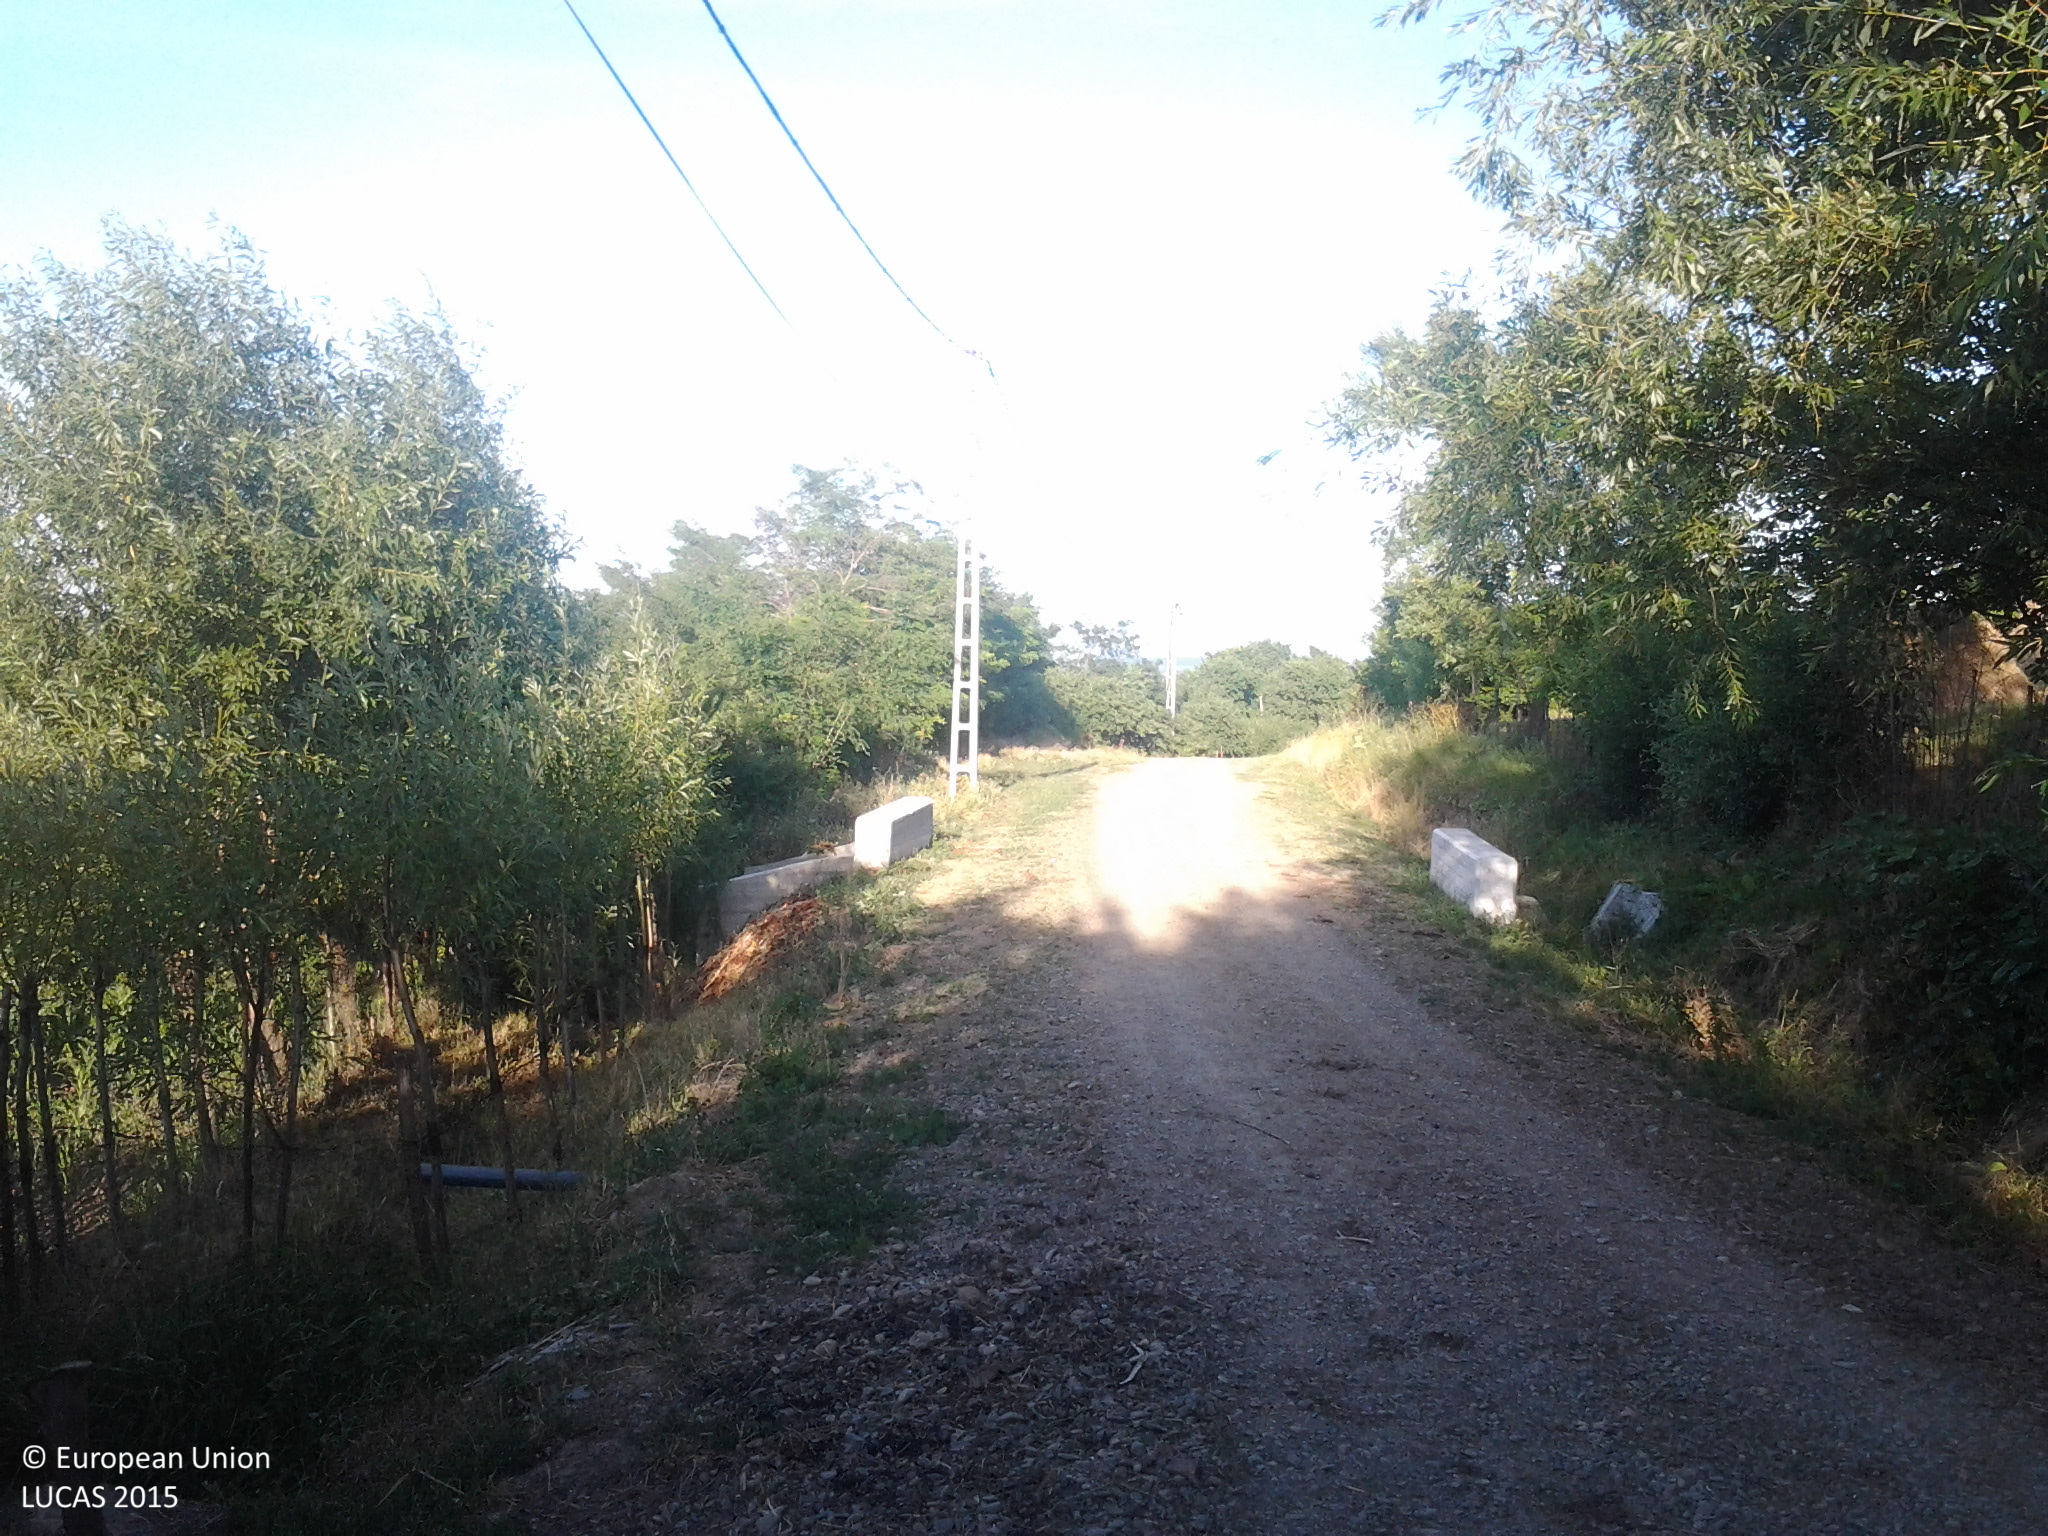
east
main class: Grassland
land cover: Grassland with sparse tree/shrub cover
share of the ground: > 75 %
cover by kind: herbaceous plants 90 %, broadleaved forest trees 5 %, shrubs 5 %
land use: Agriculture (excluding fallow land and kitchen gardens)
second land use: Residential
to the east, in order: Grassland with sparse tree/shrub cover; Fences; Grassland without tree/shrub cover; Fences; Maize; Abandoned hedges; Other fruit trees and berries; Grassland with sparse tree/shrub cover; Grassland without tree/shrub cover; Broadleaved woodland; Artificial constructions in urban areas; Grassland with sparse tree/shrub cover; Fences; Grassland without tree/shrub cover; Electric lines; Grassland without tree/shrub cover; Tracks; Grassland without tree/shrub cover
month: June
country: RO
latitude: 47.1998
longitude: 26.9022
